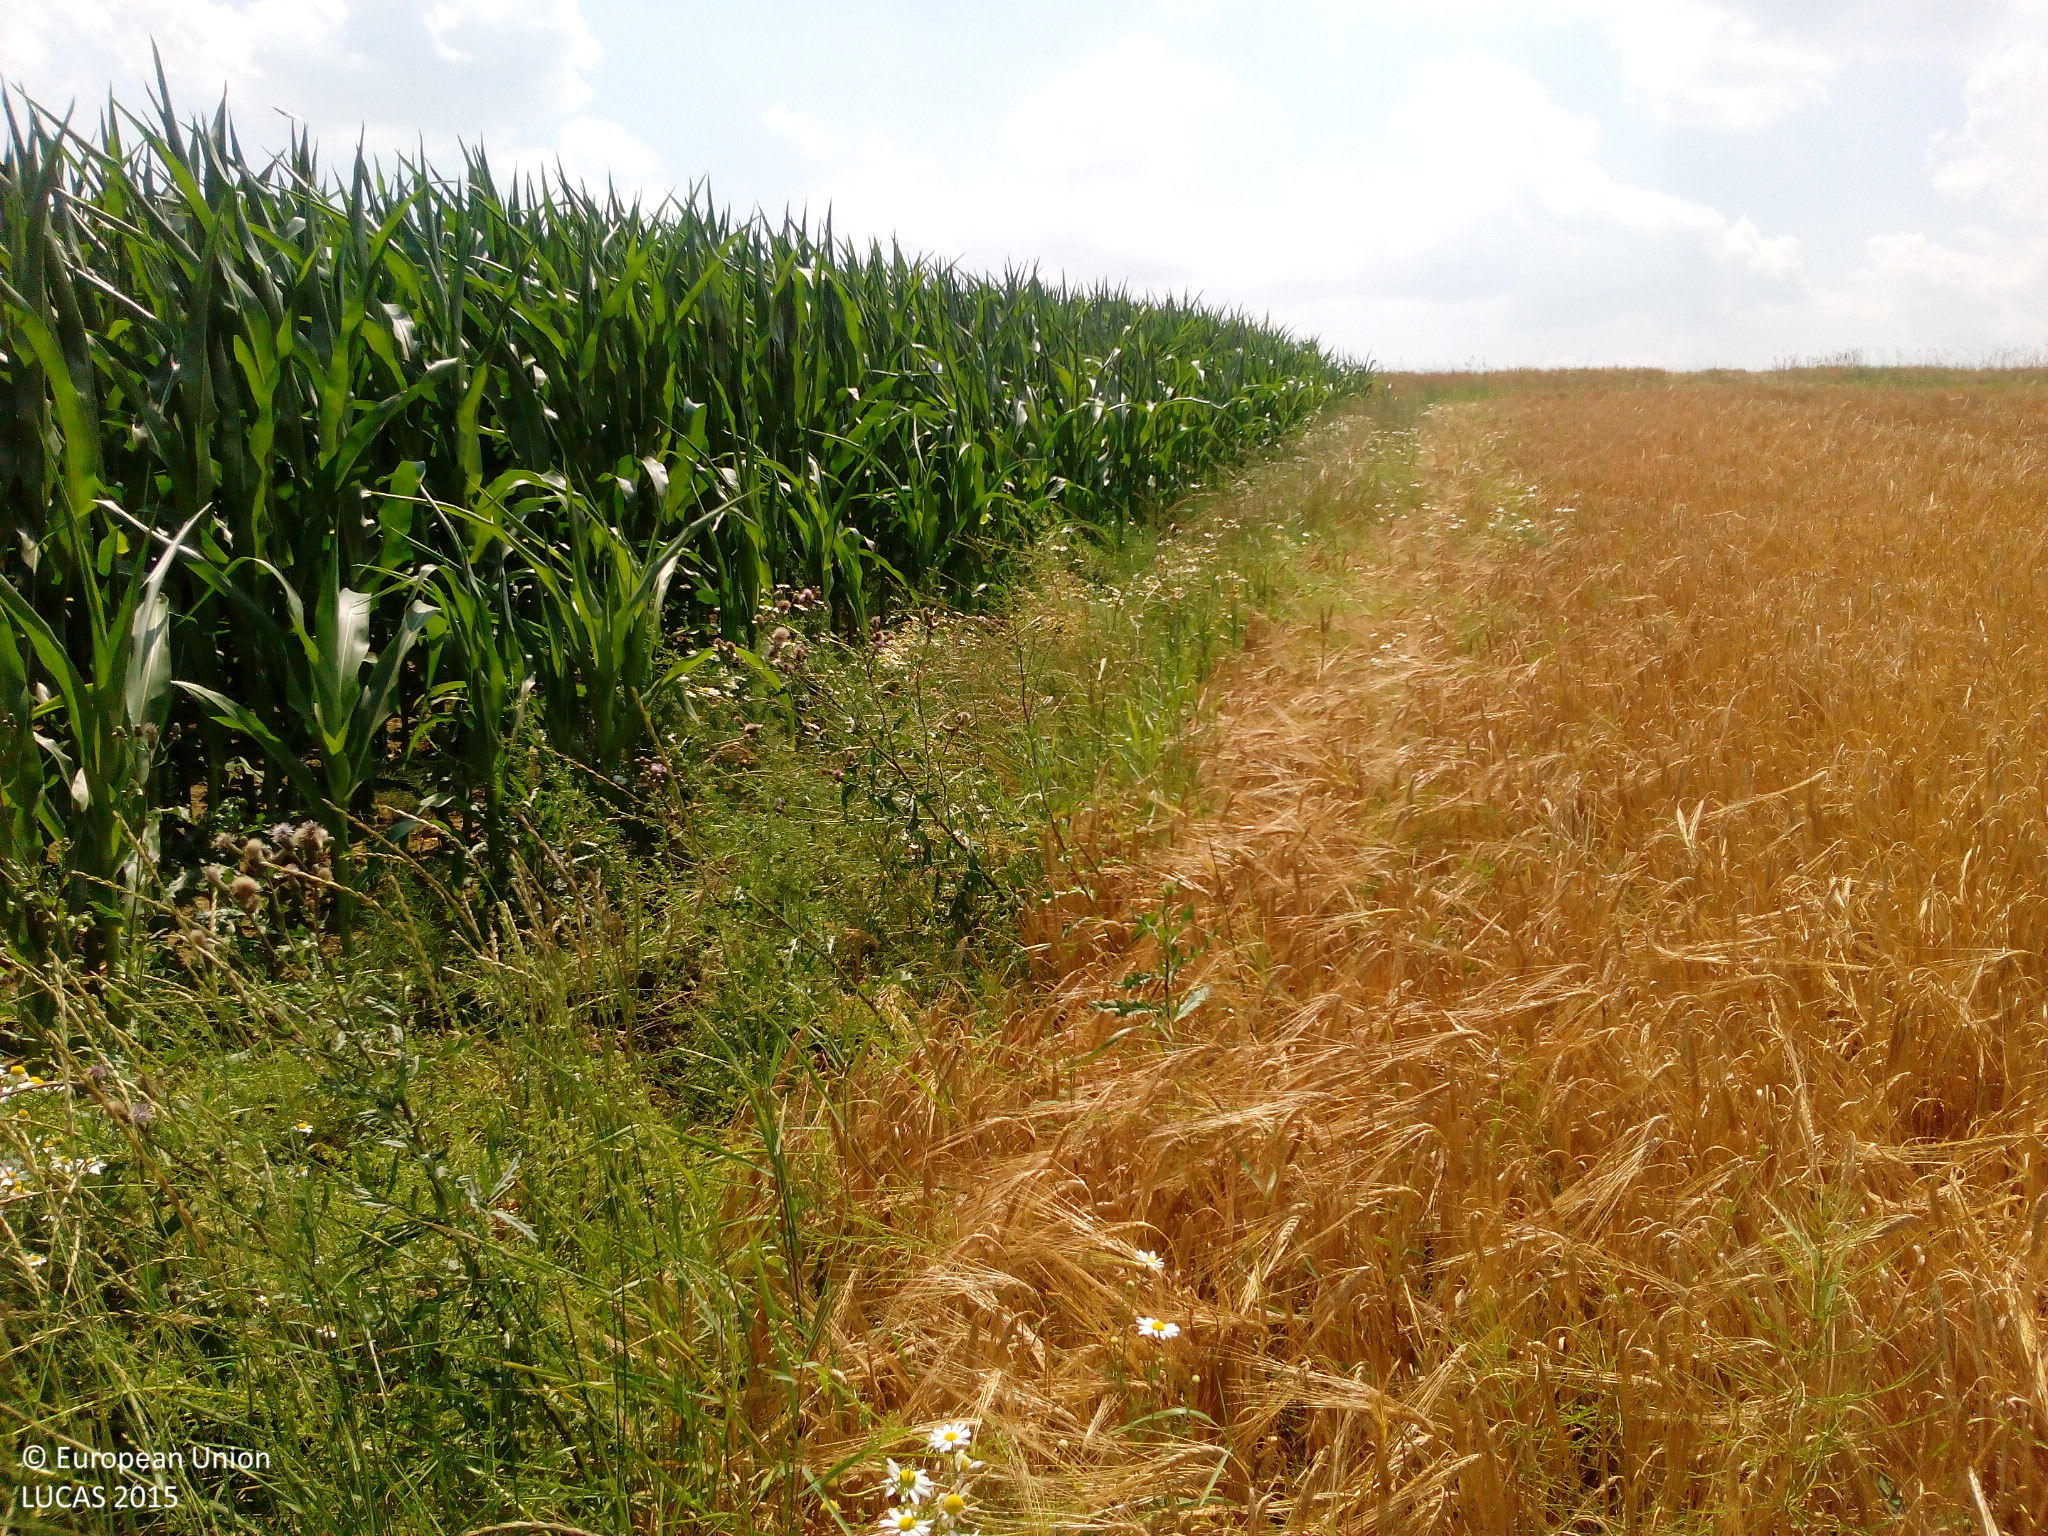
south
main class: Cropland
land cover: Barley
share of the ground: > 75 %
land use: Agriculture (excluding fallow land and kitchen gardens)
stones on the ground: < 10 %
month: July
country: DE
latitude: 48.7648
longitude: 11.9176
